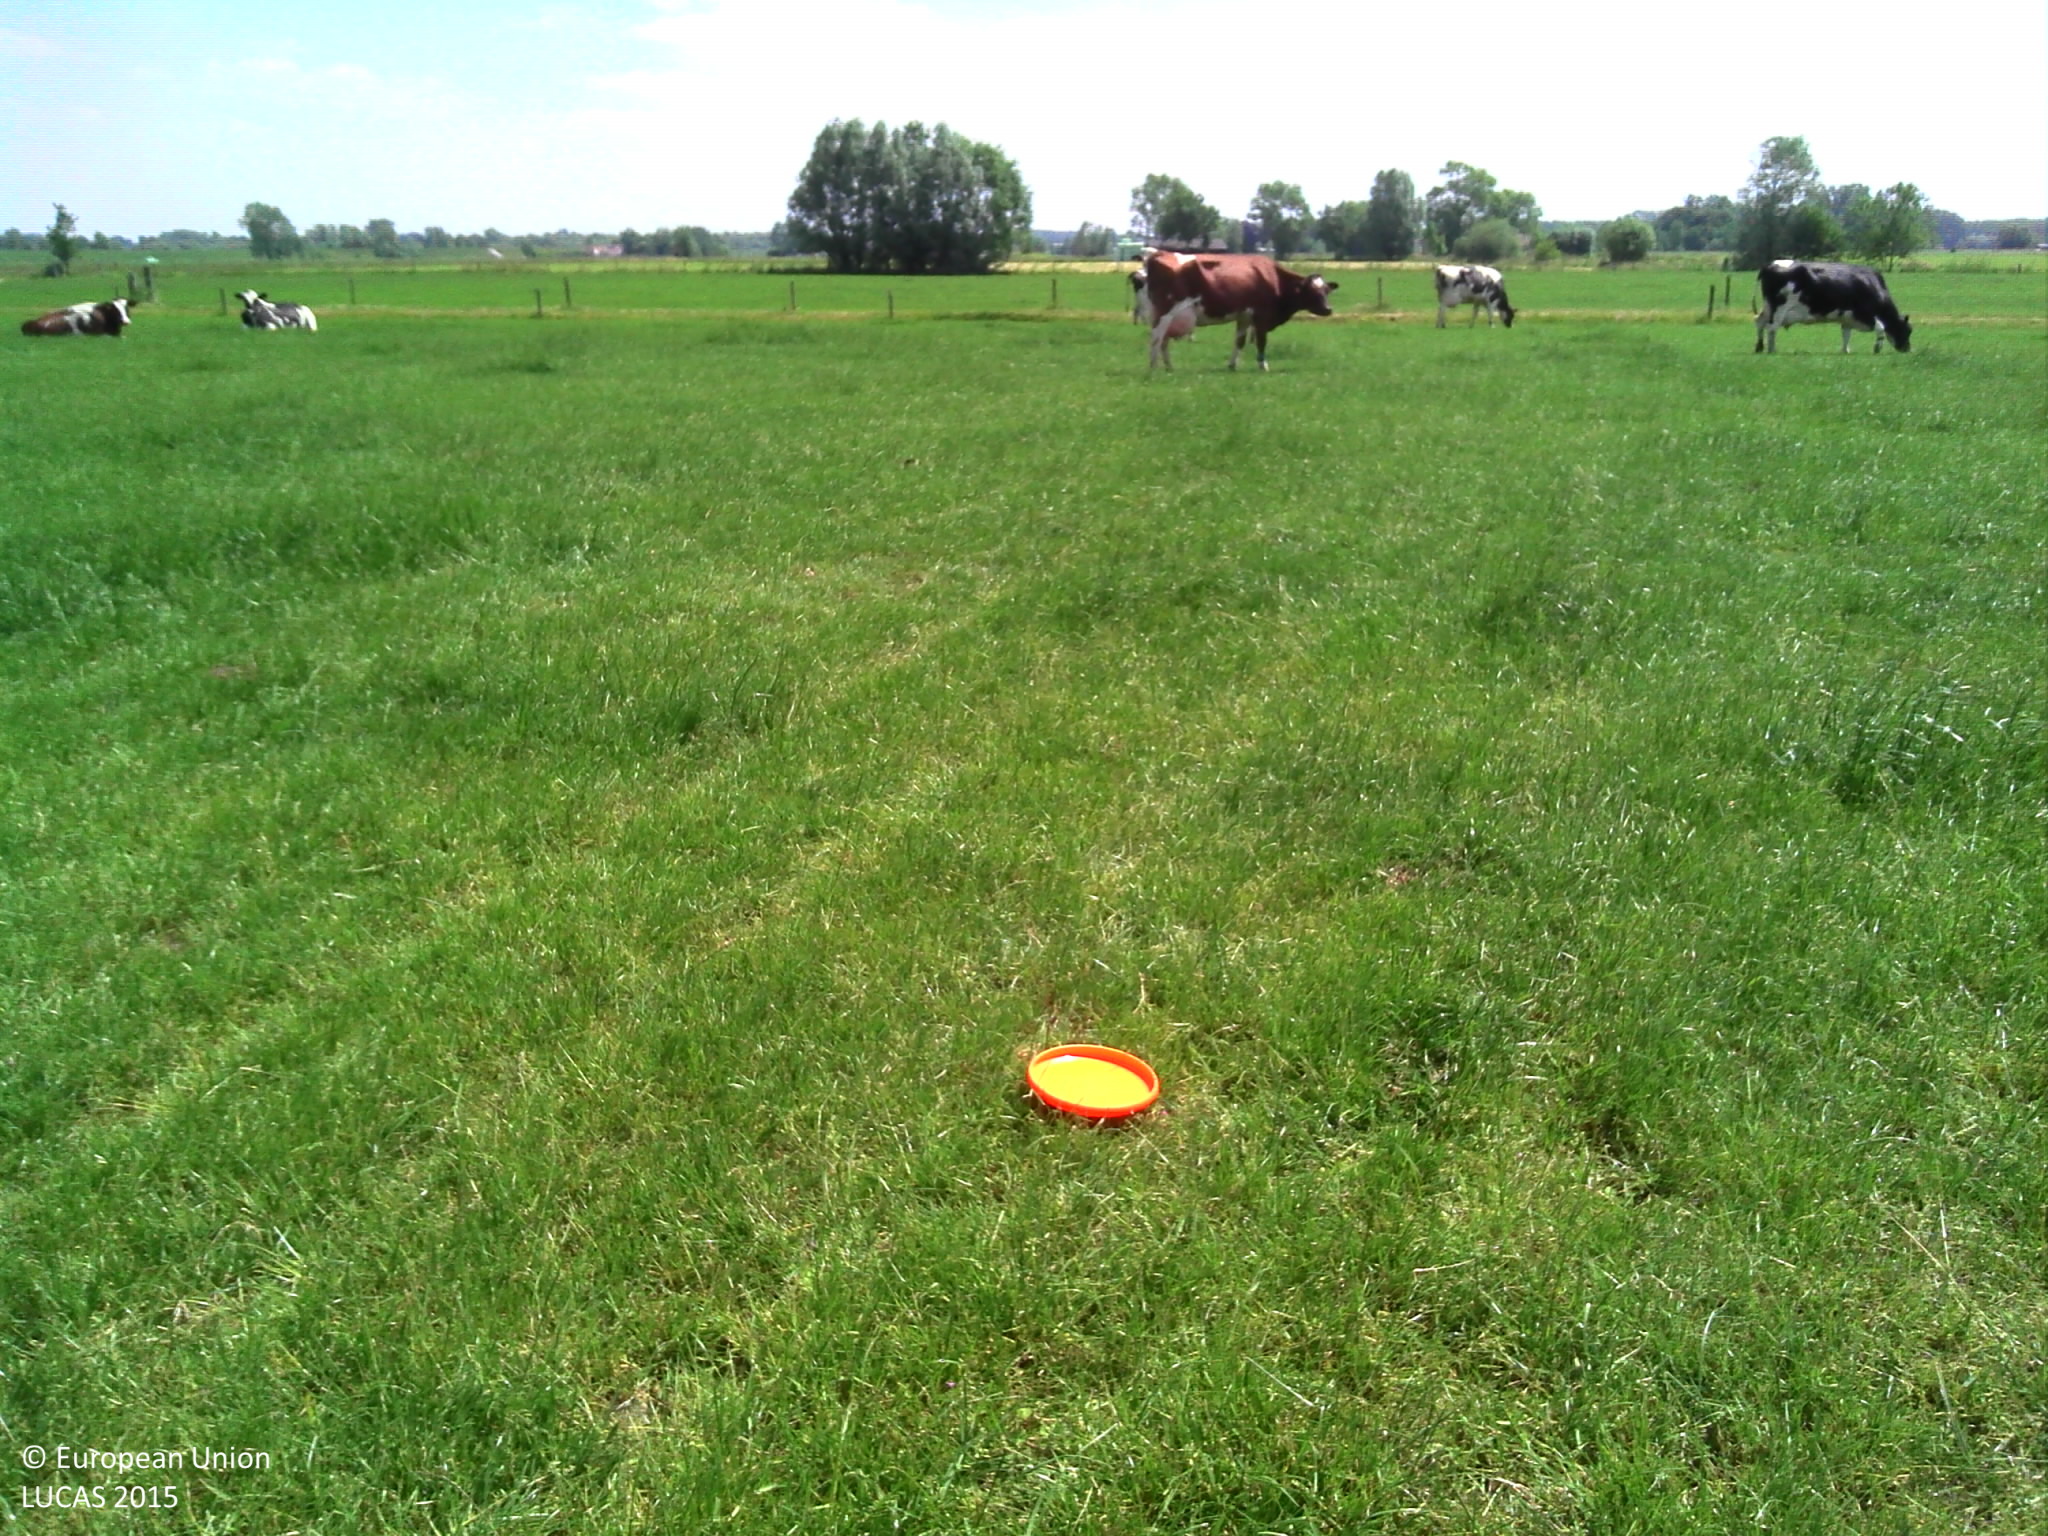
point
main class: Grassland
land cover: Grassland without tree/shrub cover
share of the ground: > 75 %
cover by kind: herbaceous plants 100 %
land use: Agriculture (excluding fallow land and kitchen gardens)
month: June
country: BE
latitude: 51.0369
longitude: 4.0188
